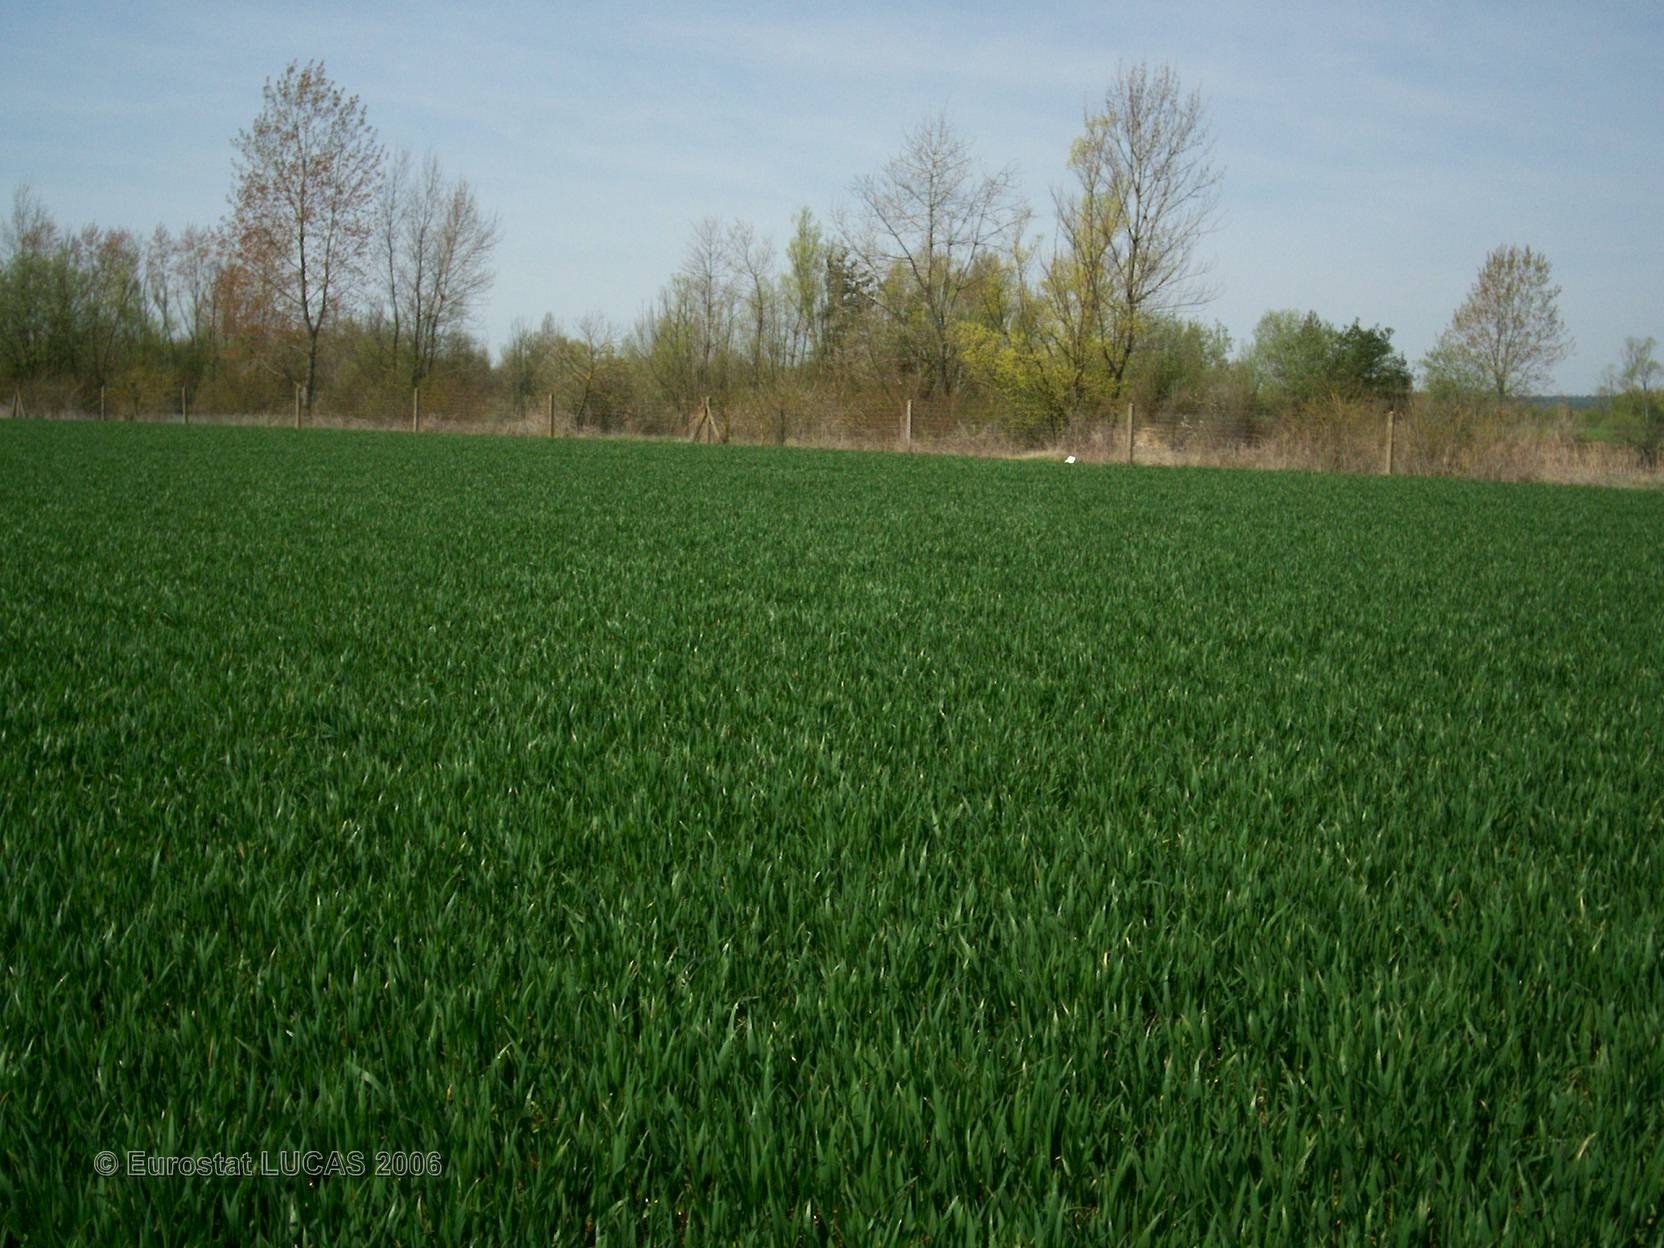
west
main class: Cropland
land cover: Common wheat
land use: Agriculture (excluding fallow land and kitchen gardens)
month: April
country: FR
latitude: 48.4301
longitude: 4.5238
